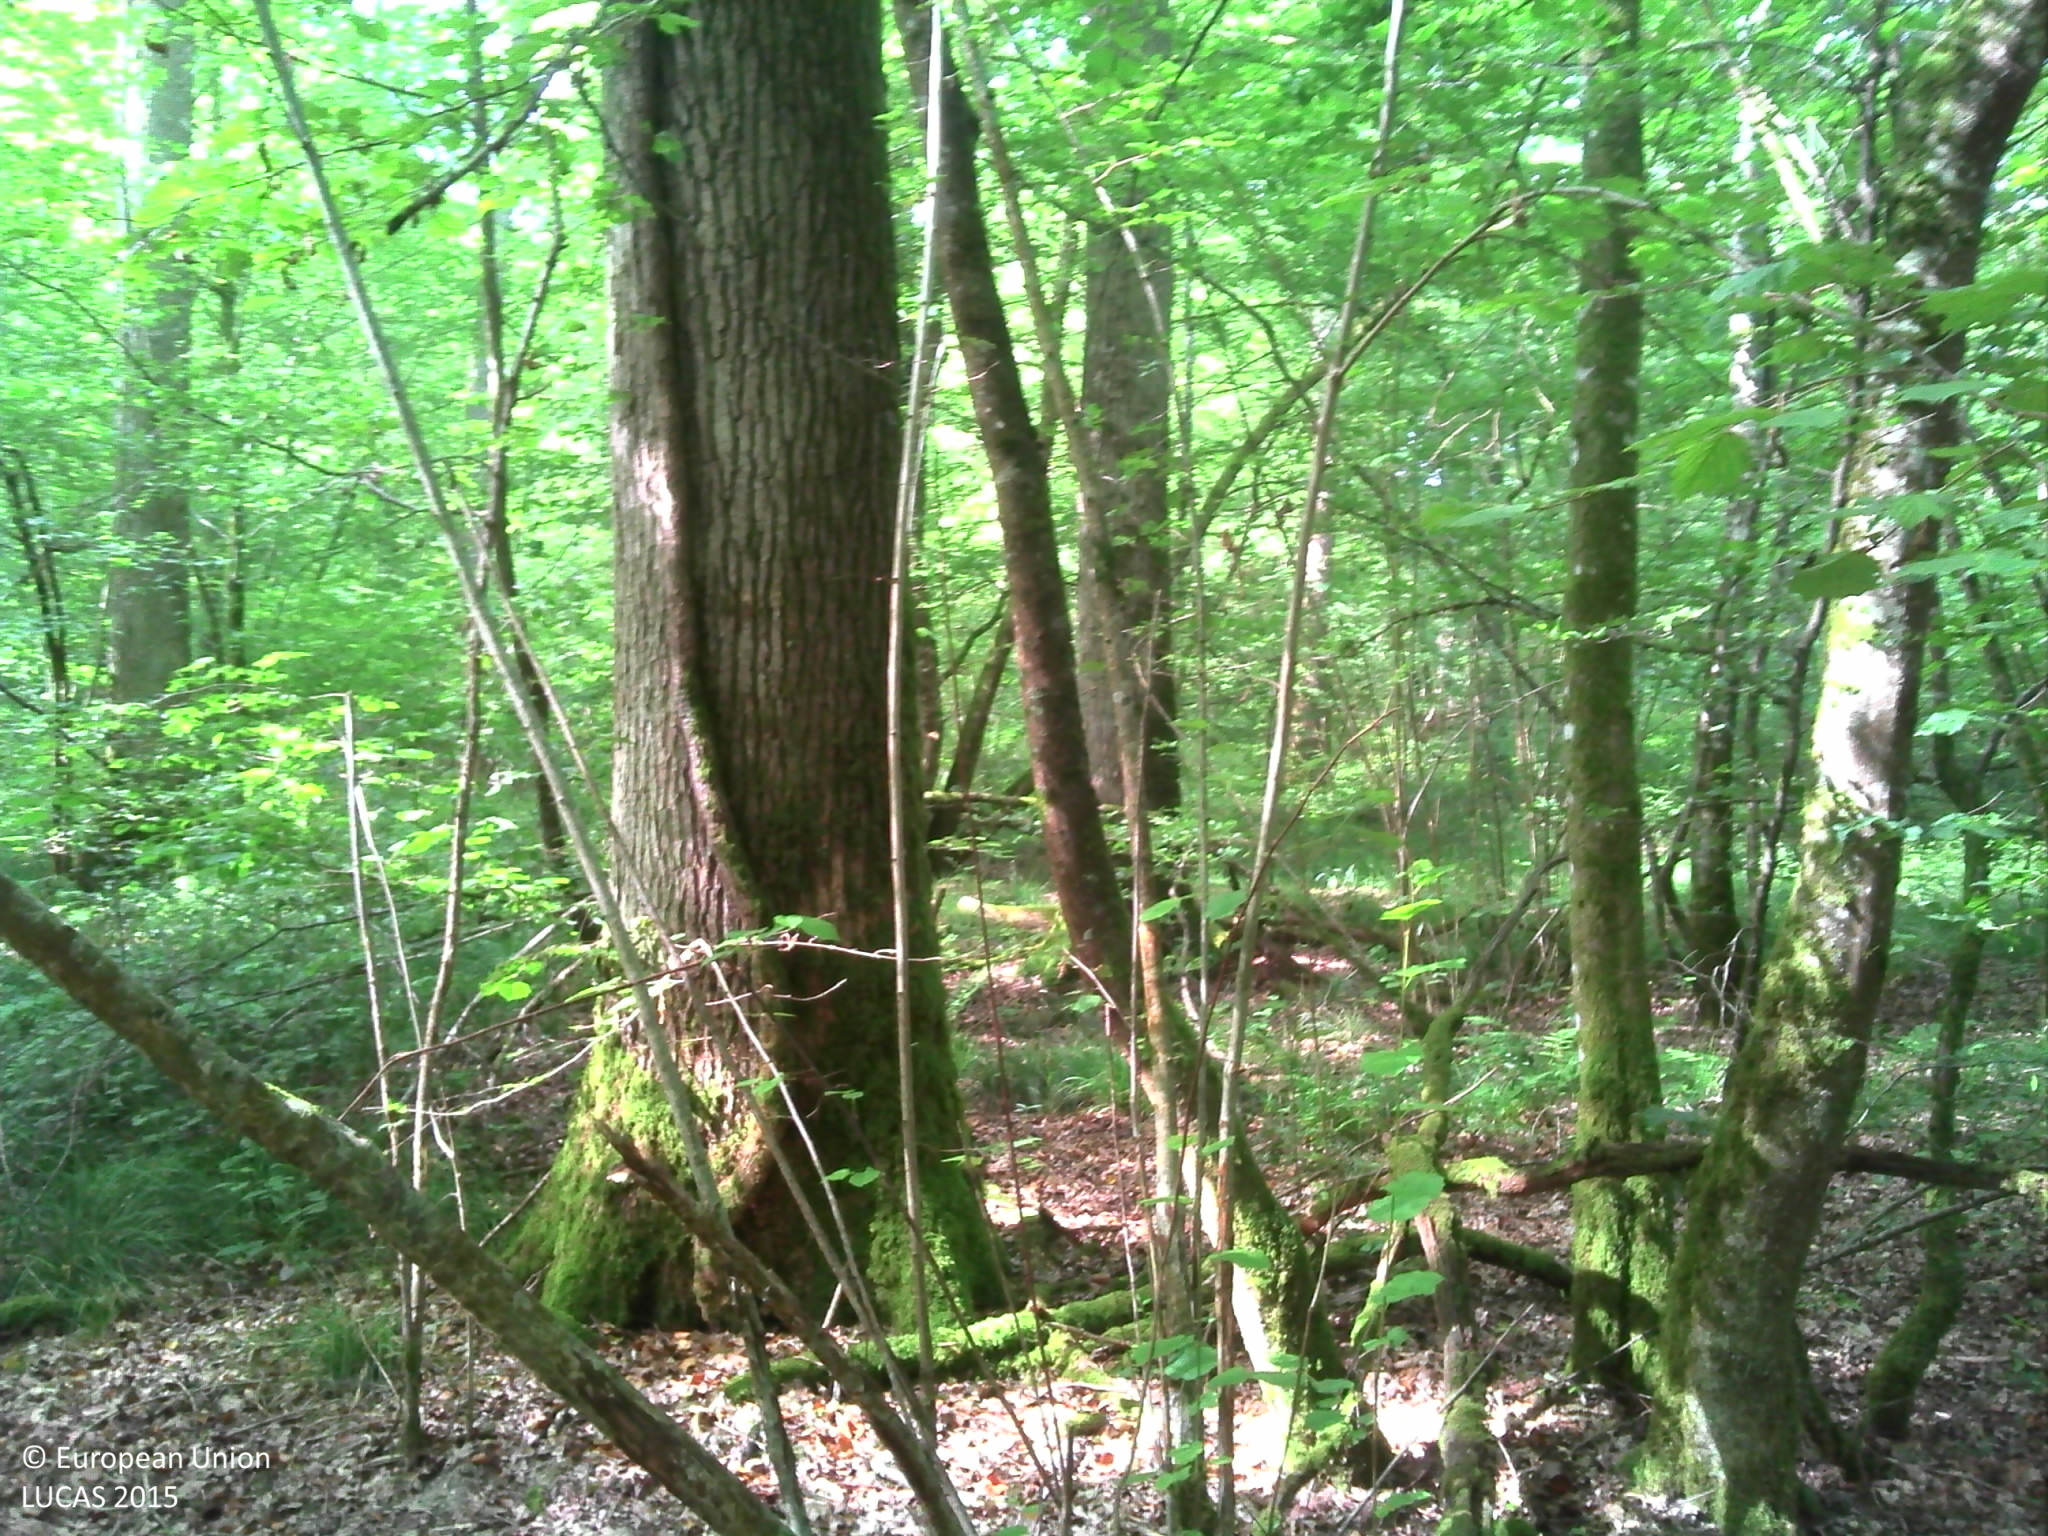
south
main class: Woodland
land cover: Broadleaved woodland
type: mesophytic deciduous forest
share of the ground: > 75 %
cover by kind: broadleaved forest trees 95 %, herbaceous plants 5 %
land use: Forestry
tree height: > 5 m
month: June
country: FR
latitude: 46.8989
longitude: 2.9996
